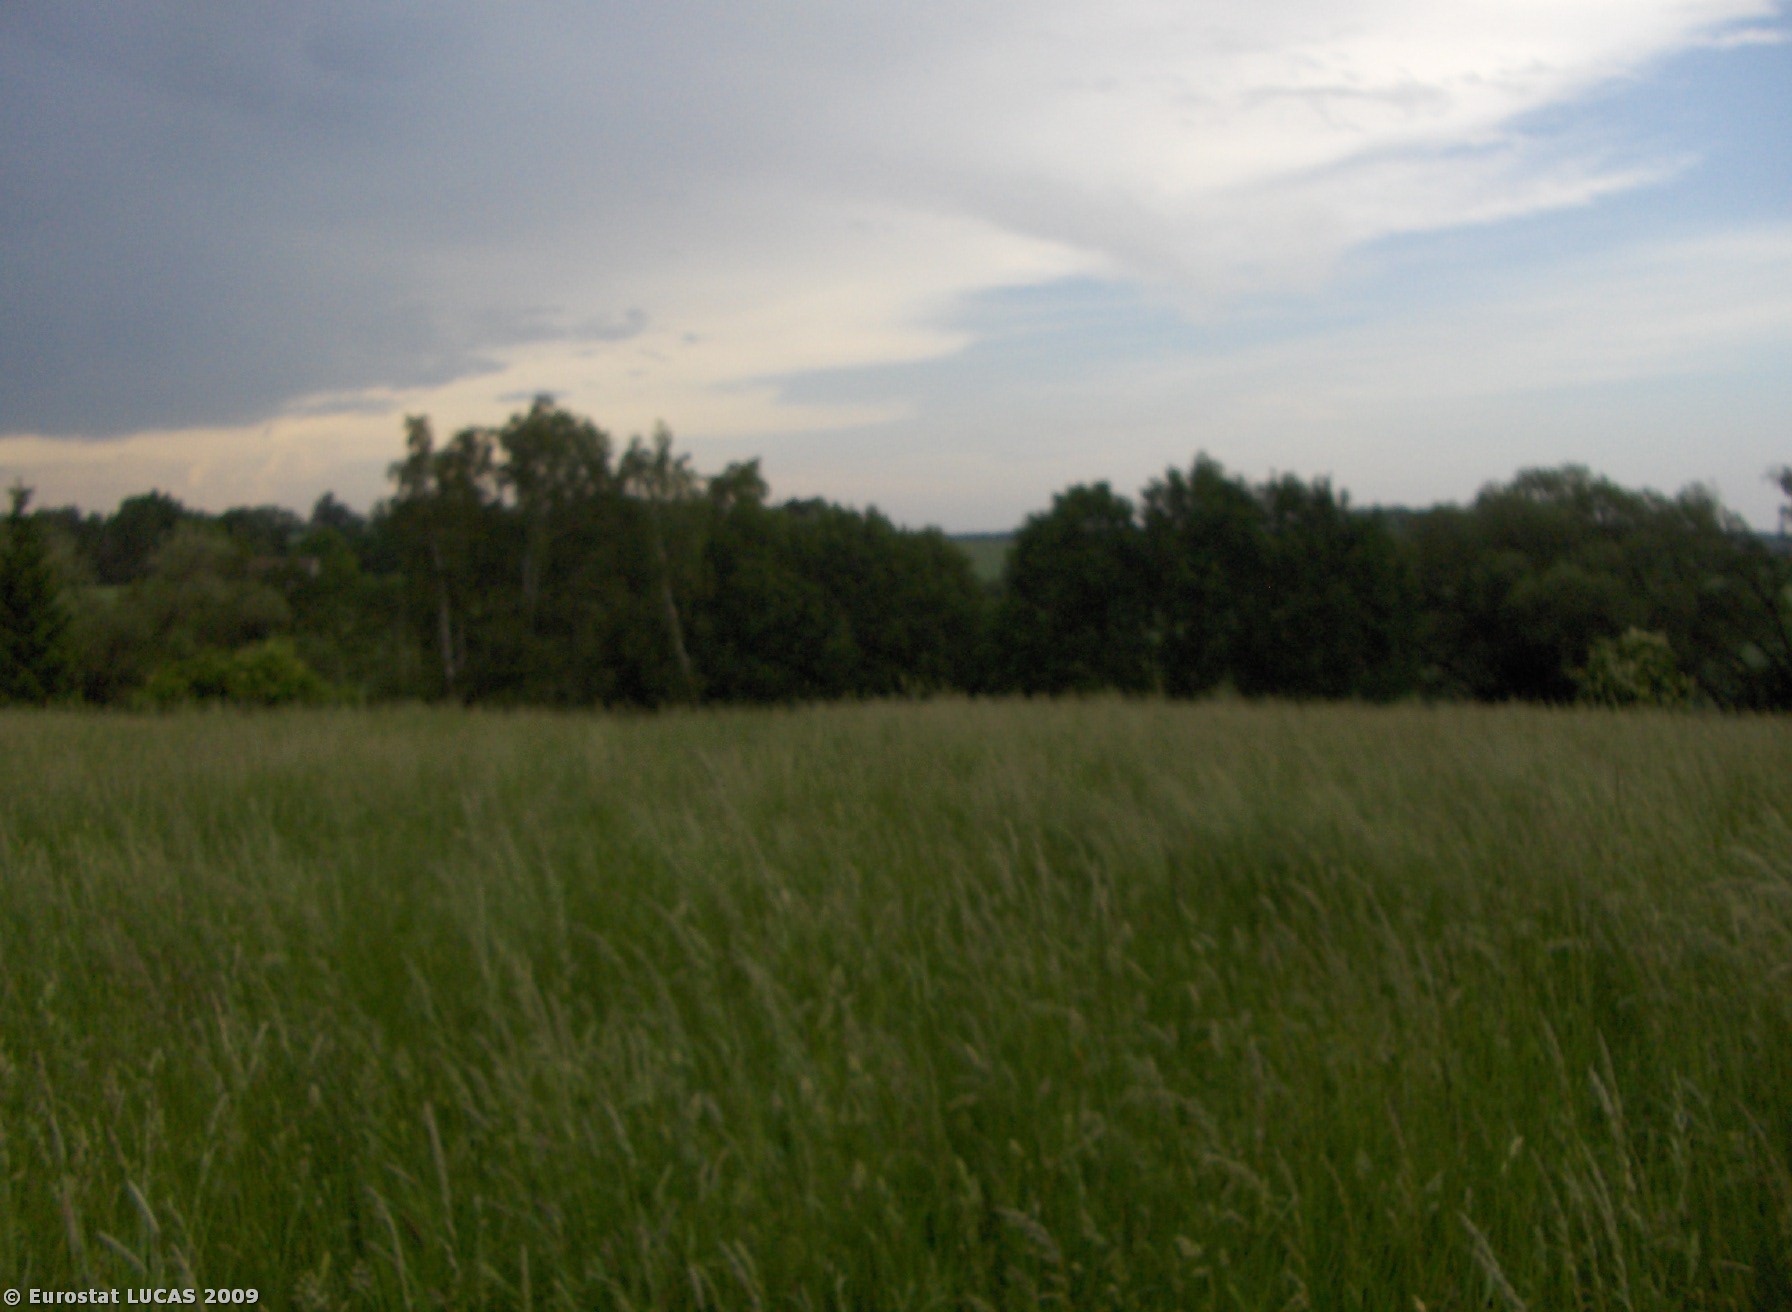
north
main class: Grassland
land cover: Grassland without tree/shrub cover
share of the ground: > 75 %
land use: Agriculture (excluding fallow land and kitchen gardens)
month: May
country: CZ
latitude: 49.1561
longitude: 14.5674
